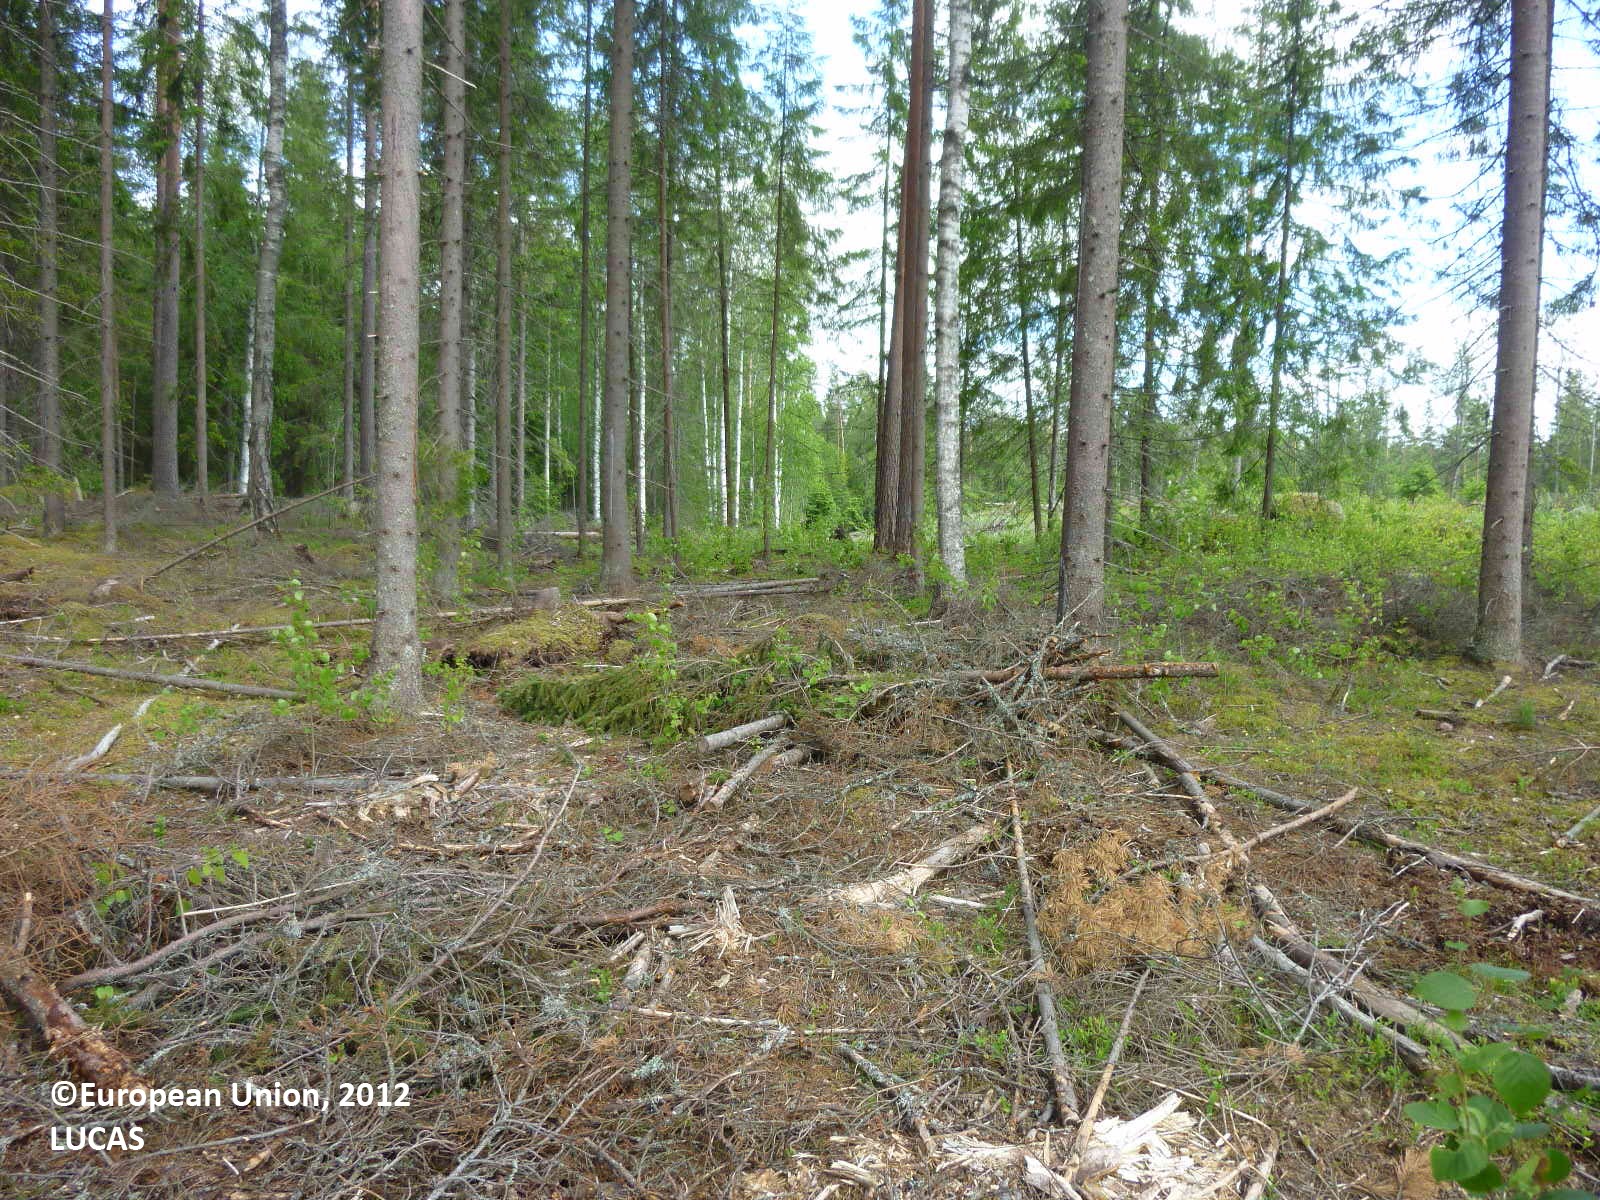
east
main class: Woodland
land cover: Spruce dominated mixed woodland
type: boreal forest
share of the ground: 50 - 75 %
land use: Forestry
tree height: > 5 m
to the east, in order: Spruce dominated mixed woodland; Shrubland without tree cover; Tracks; Spruce dominated mixed woodland; Ditches and canals; Pine dominated mixed woodland; Ditches and canals; Pine dominated mixed woodland; Spruce dominated mixed woodland
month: June
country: FI
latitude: 61.7395
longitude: 22.3082
